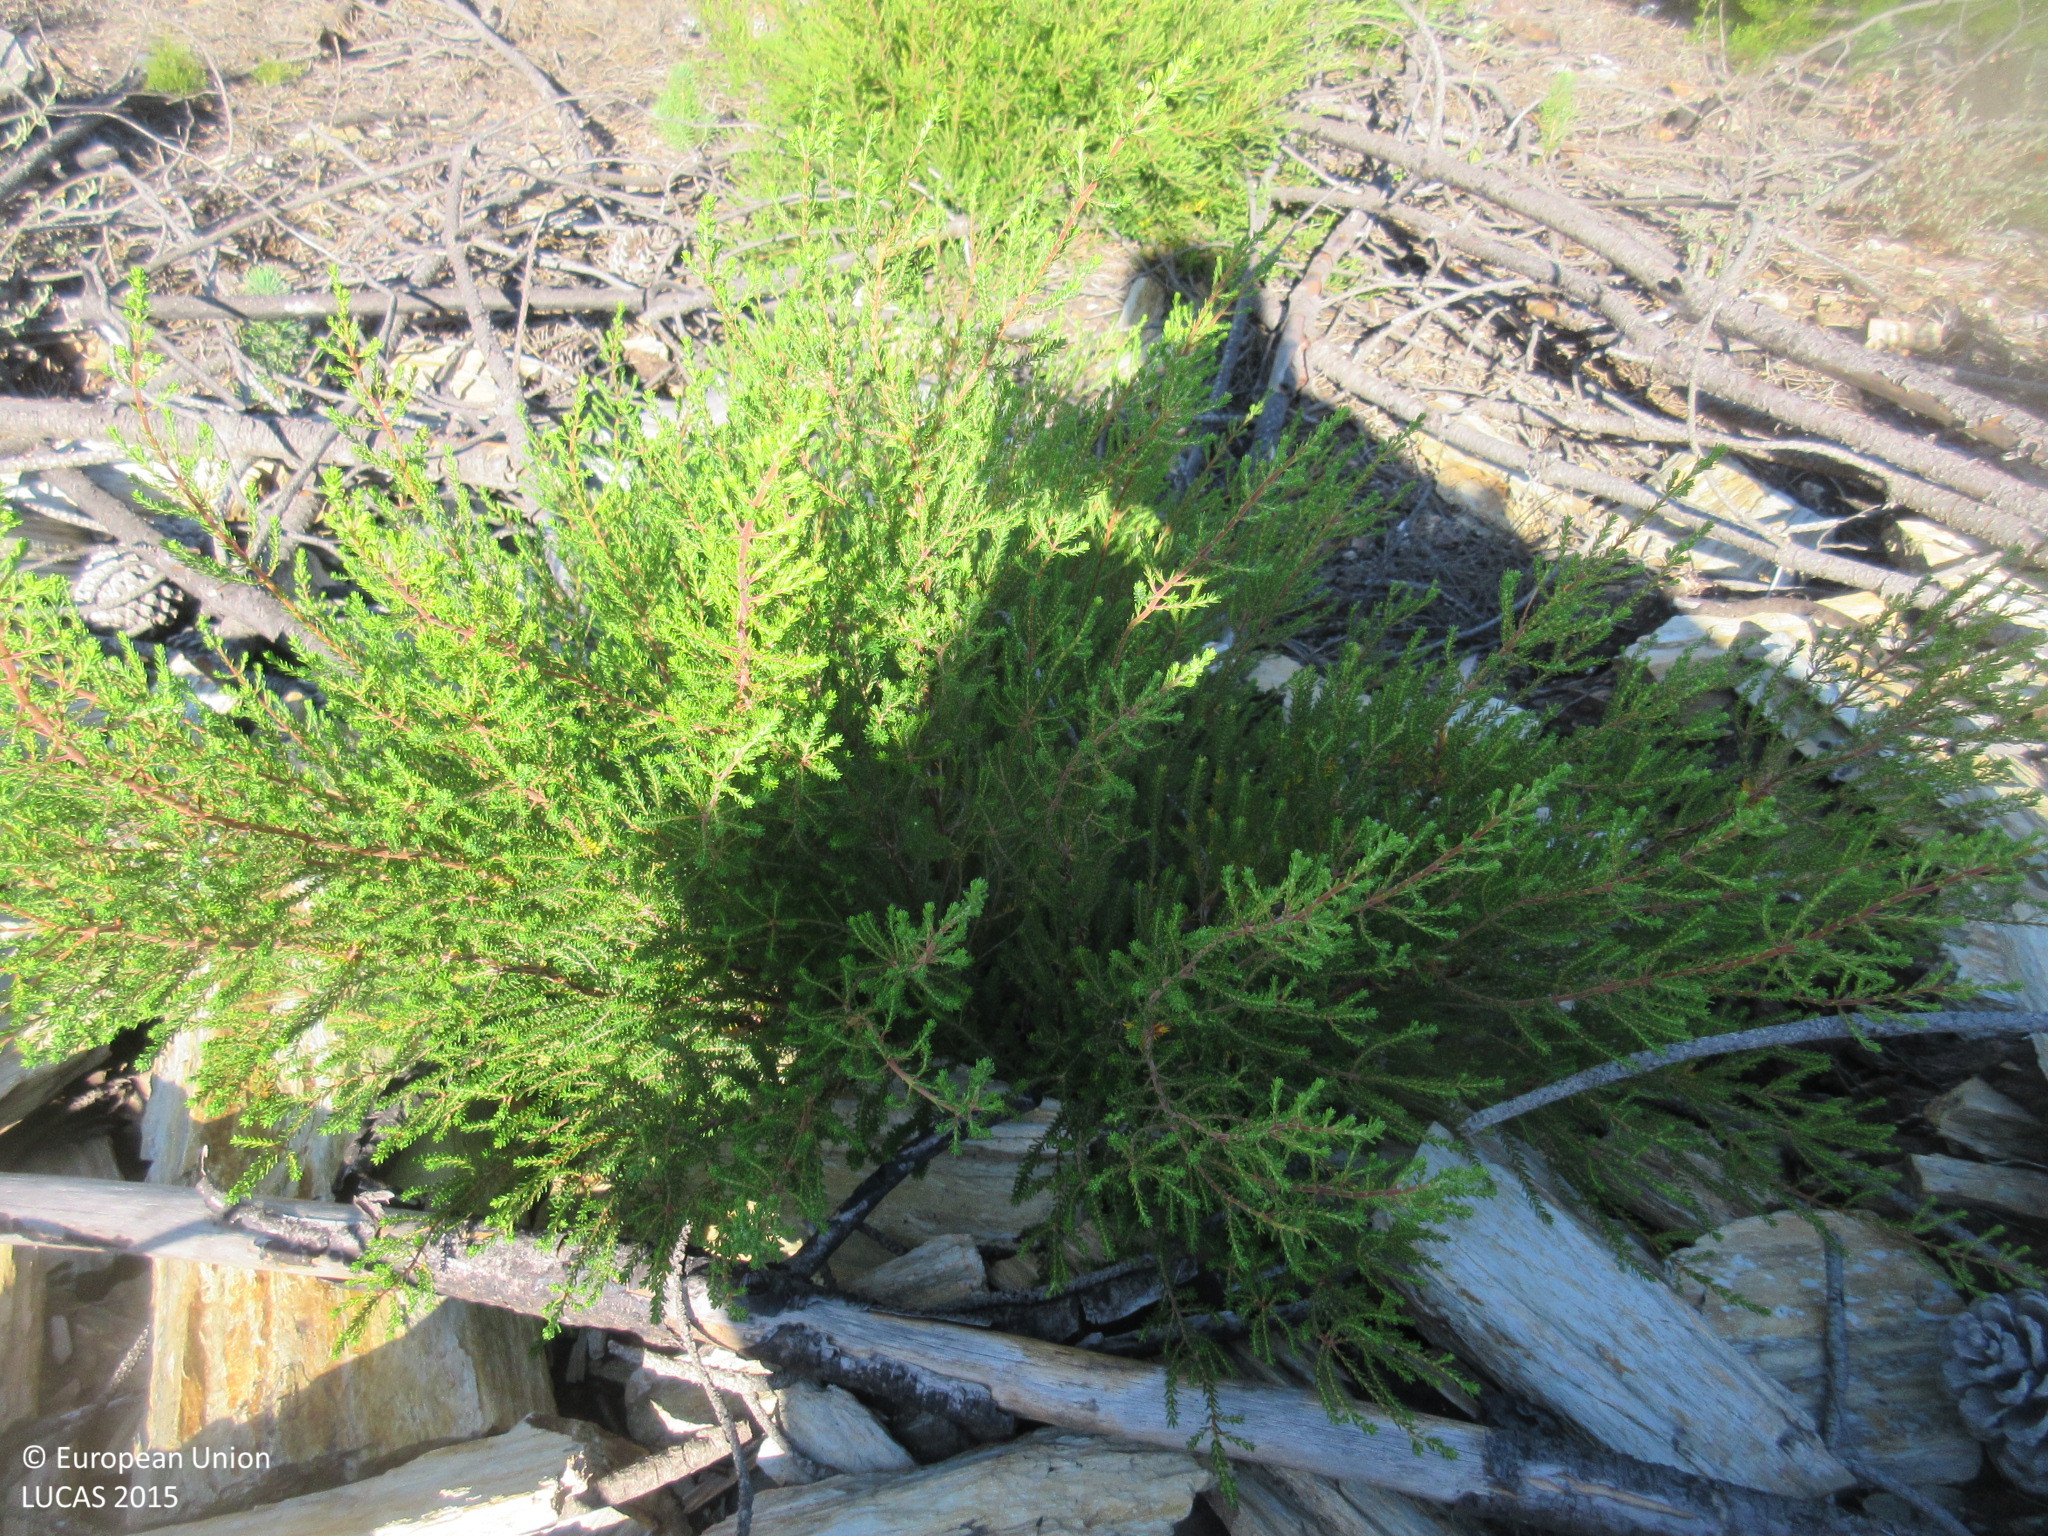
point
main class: Shrubland
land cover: Shrubland without tree cover
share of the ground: 50 - 75 %
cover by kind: shrubs 65 %, unconsolidated bare surface 35 %
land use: Forestry
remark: Clear cut
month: June
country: ES
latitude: 43.0822
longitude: -7.0015
